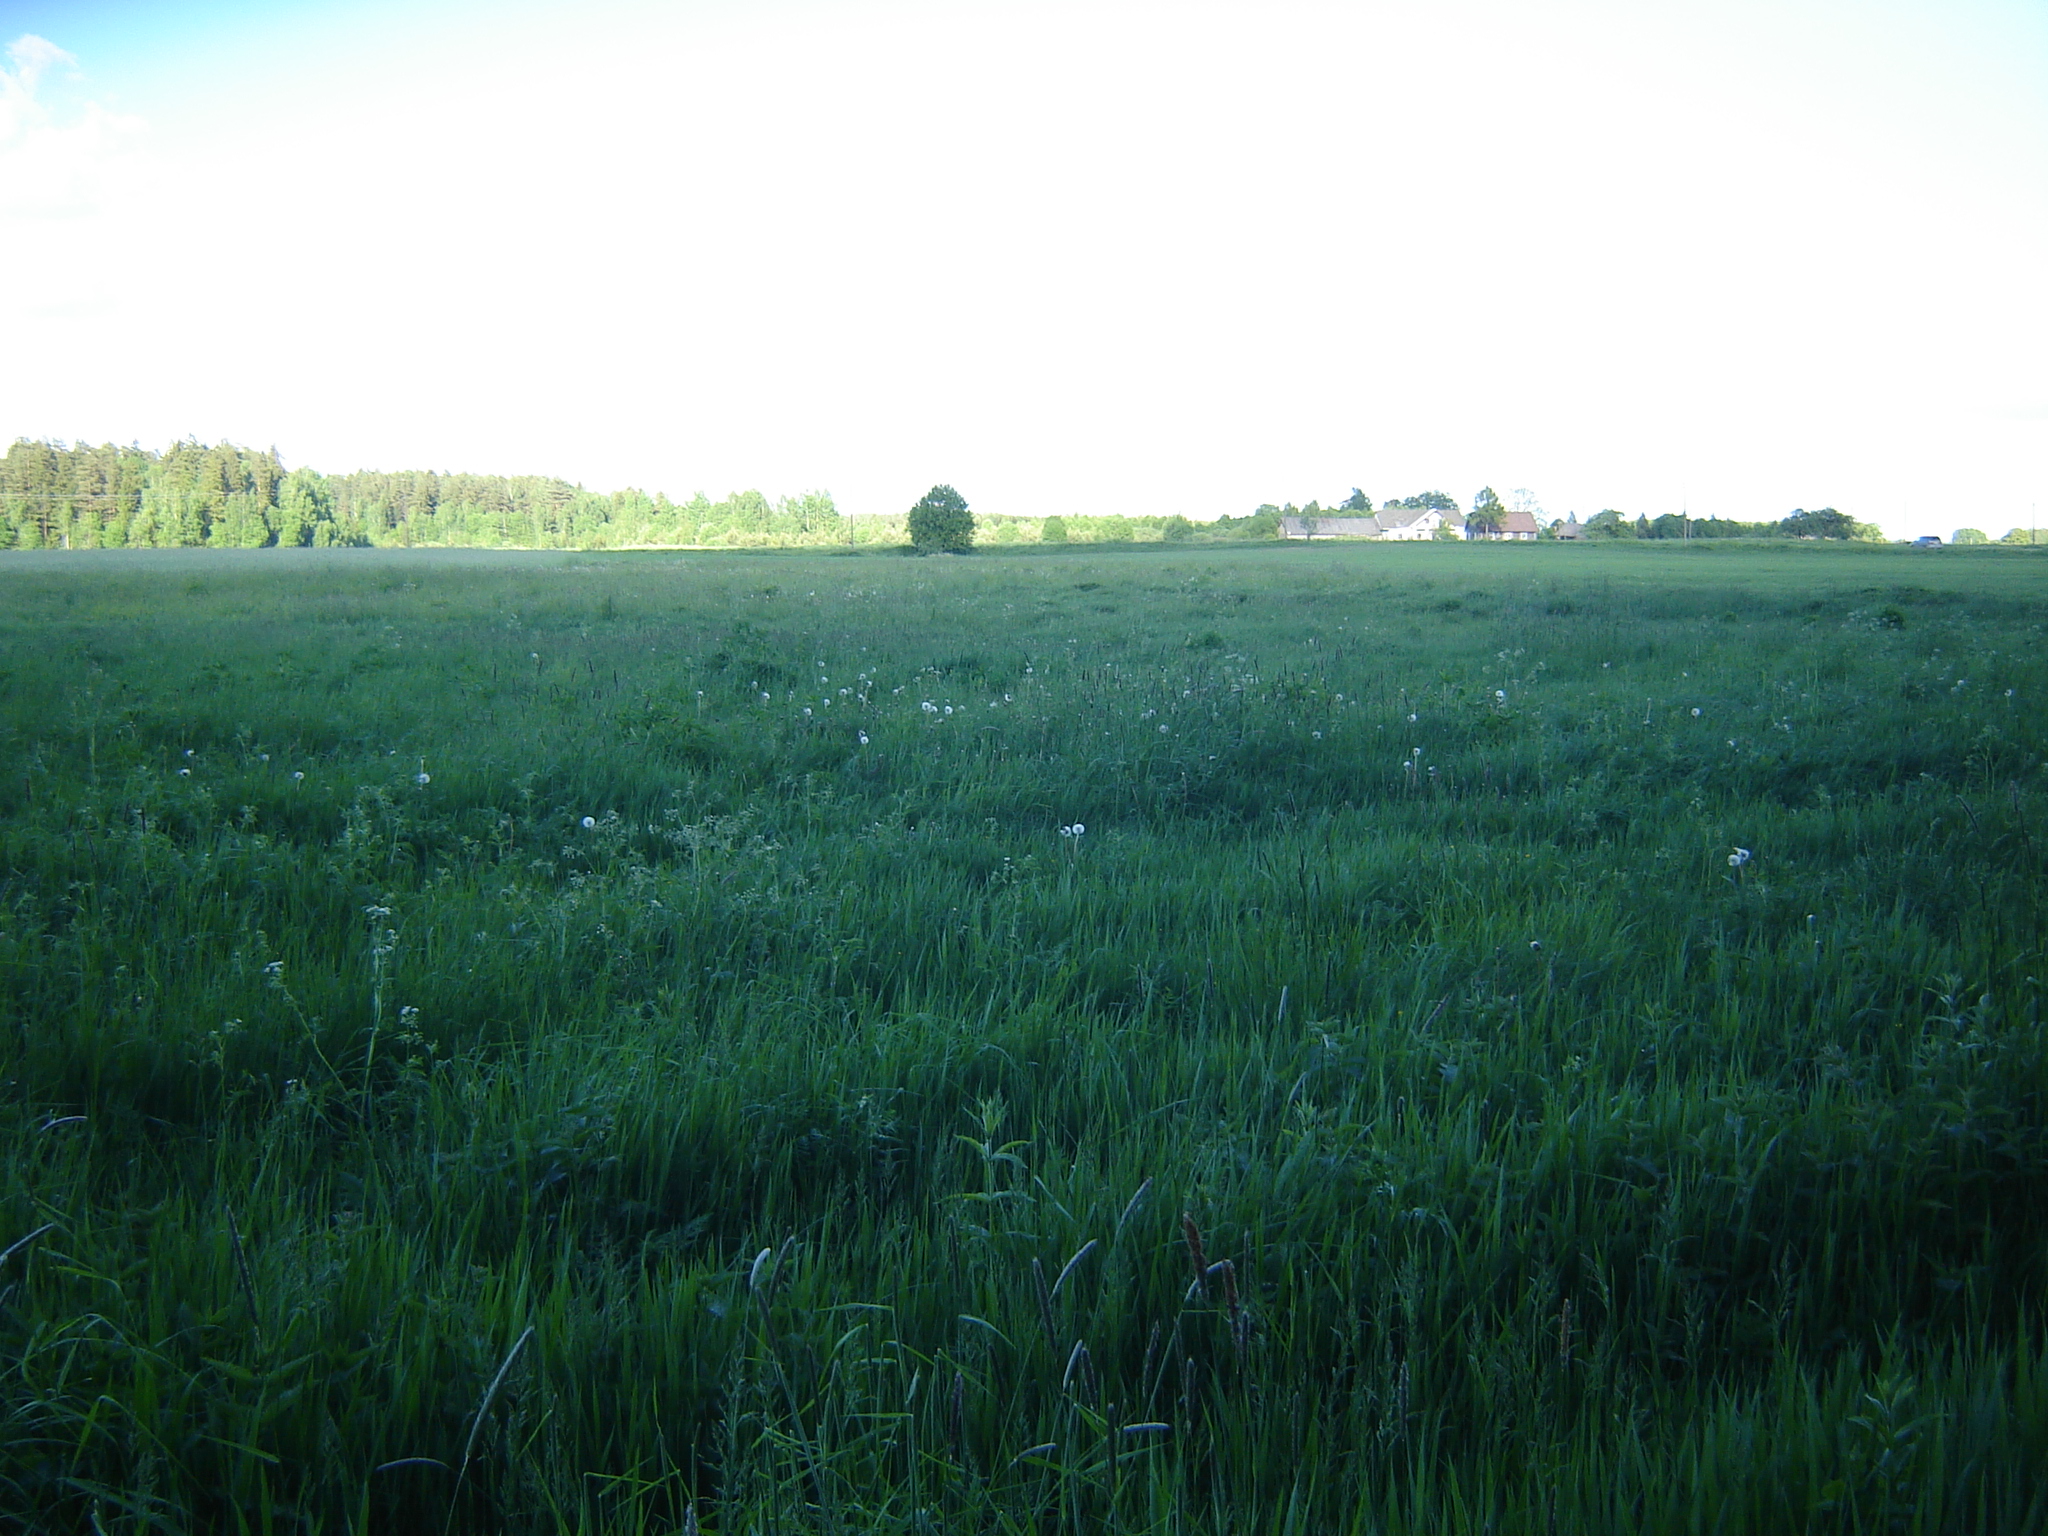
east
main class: Grassland
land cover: Spontaneously vegetated surfaces
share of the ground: > 75 %
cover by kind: herbaceous plants 100 %
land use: Fallow land
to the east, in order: Spontaneously vegetated surfaces; Grassland without tree/shrub cover; Oats; Grassland without tree/shrub cover; Electric lines; Grassland without tree/shrub cover; Paved roads, cycling and walking lanes; Grass margins; Other leguminous and mixtures for fodder
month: May
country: LT
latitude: 55.7645
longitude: 25.2418
